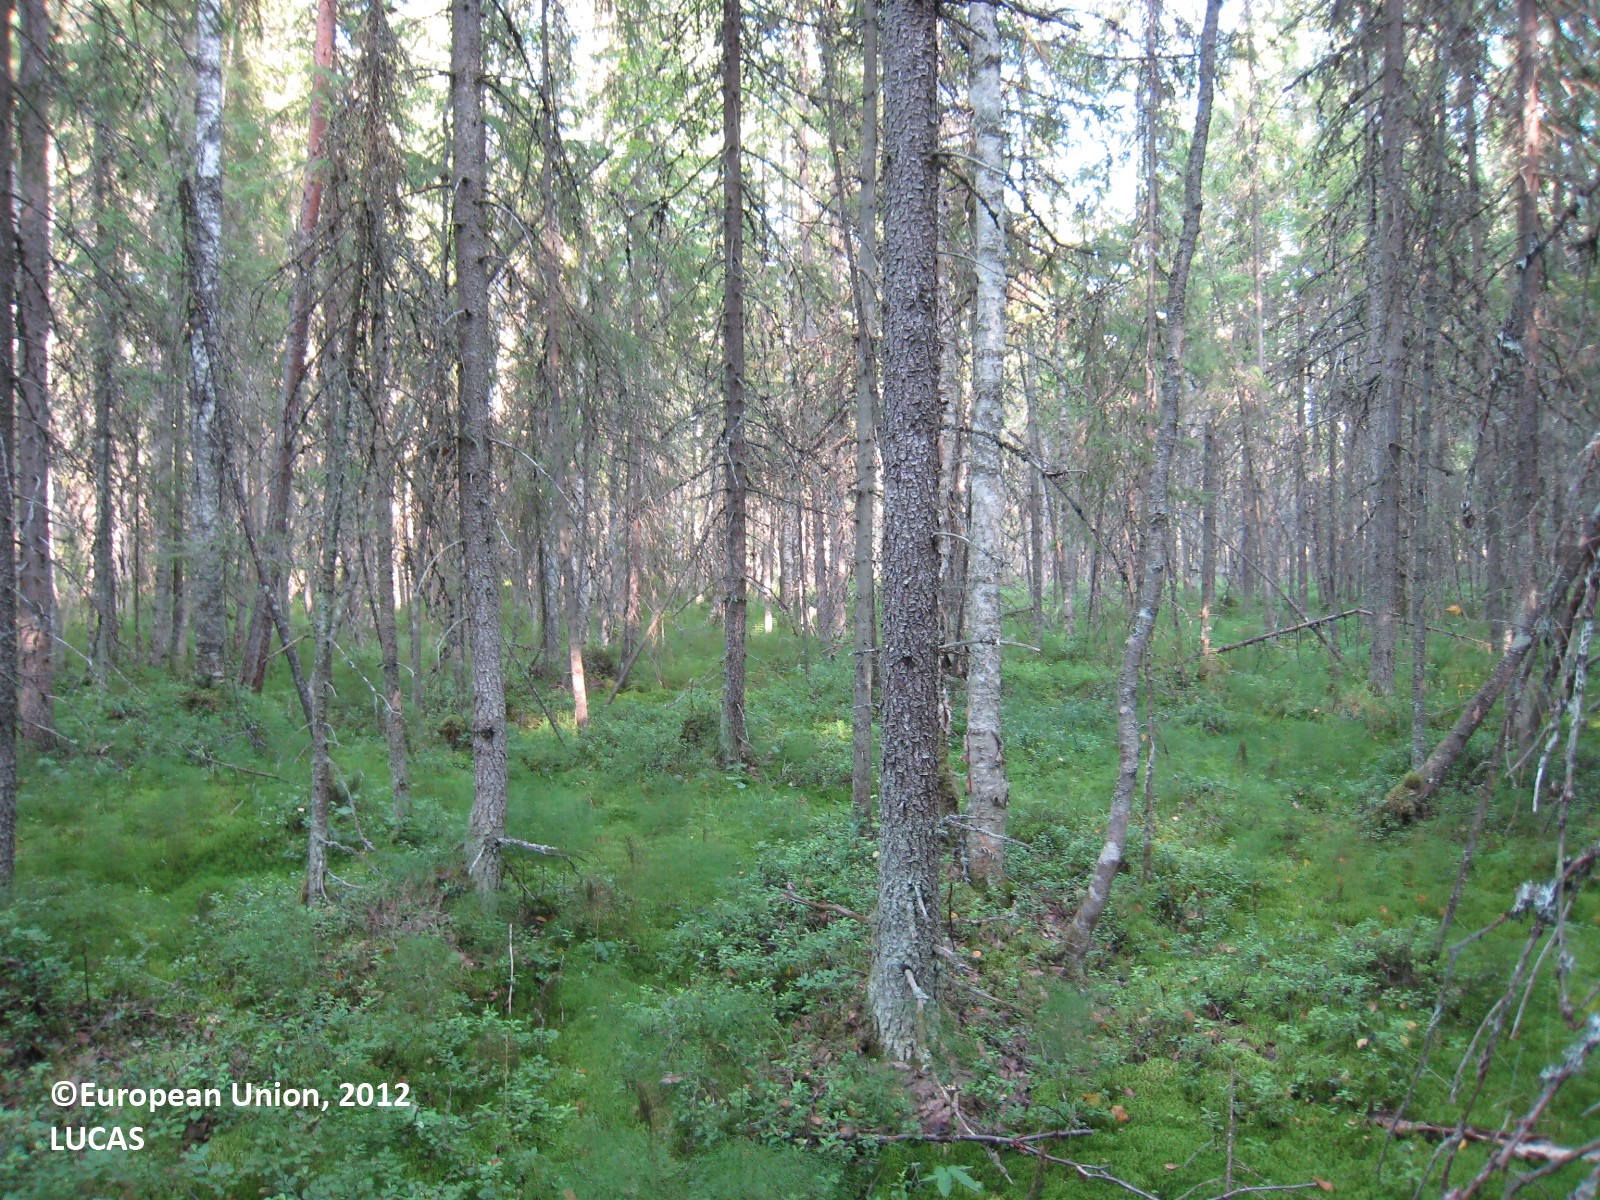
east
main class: Woodland
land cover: Spruce dominated mixed woodland
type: mire and swamp forests
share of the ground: > 75 %
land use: Forestry
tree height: > 5 m
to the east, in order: Spruce dominated mixed woodland; Other mixed woodland; Pine dominated mixed woodland; Pine dominated coniferous woodland
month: July
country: FI
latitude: 62.5892
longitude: 27.3946
